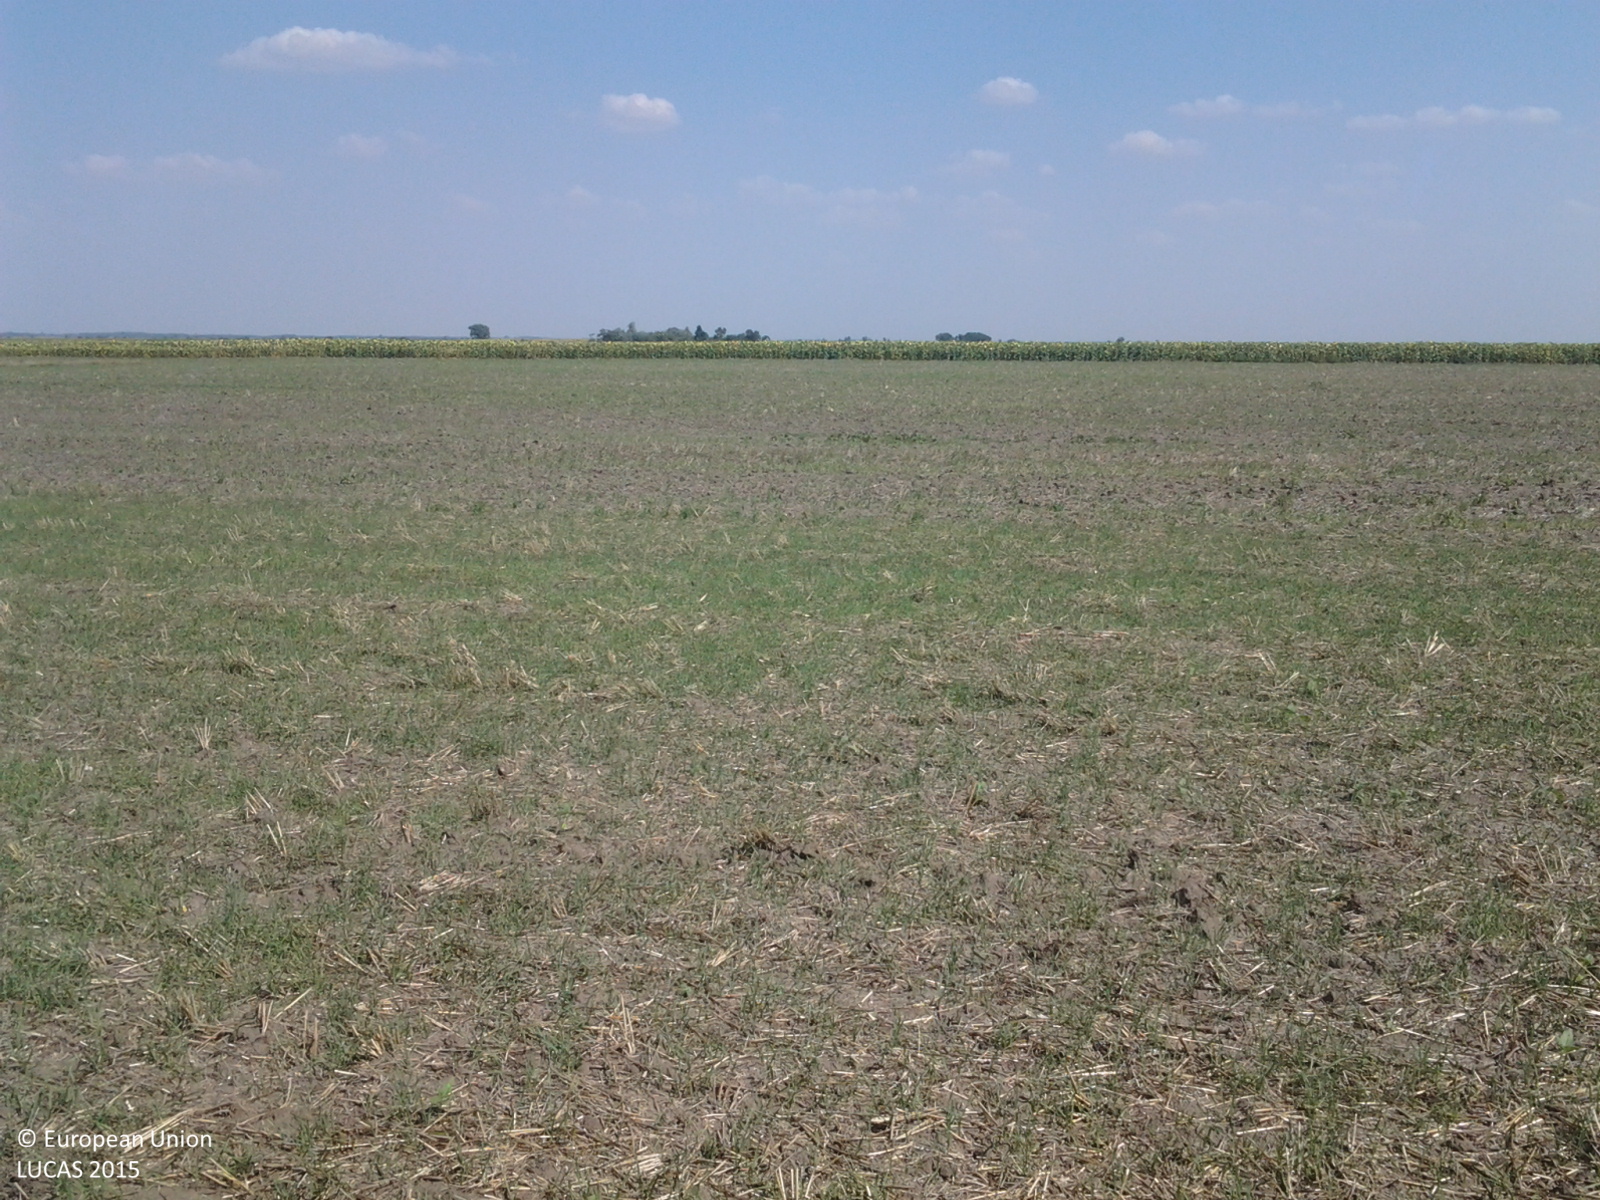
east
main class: Cropland
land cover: Common wheat
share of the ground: 10 - 25 %
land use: Agriculture (excluding fallow land and kitchen gardens)
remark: Harvested field
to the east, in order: Common wheat; Barley; Sunflower; Barley; Rape and turnip rape
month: August
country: HU
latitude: 47.2861
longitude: 19.7140
